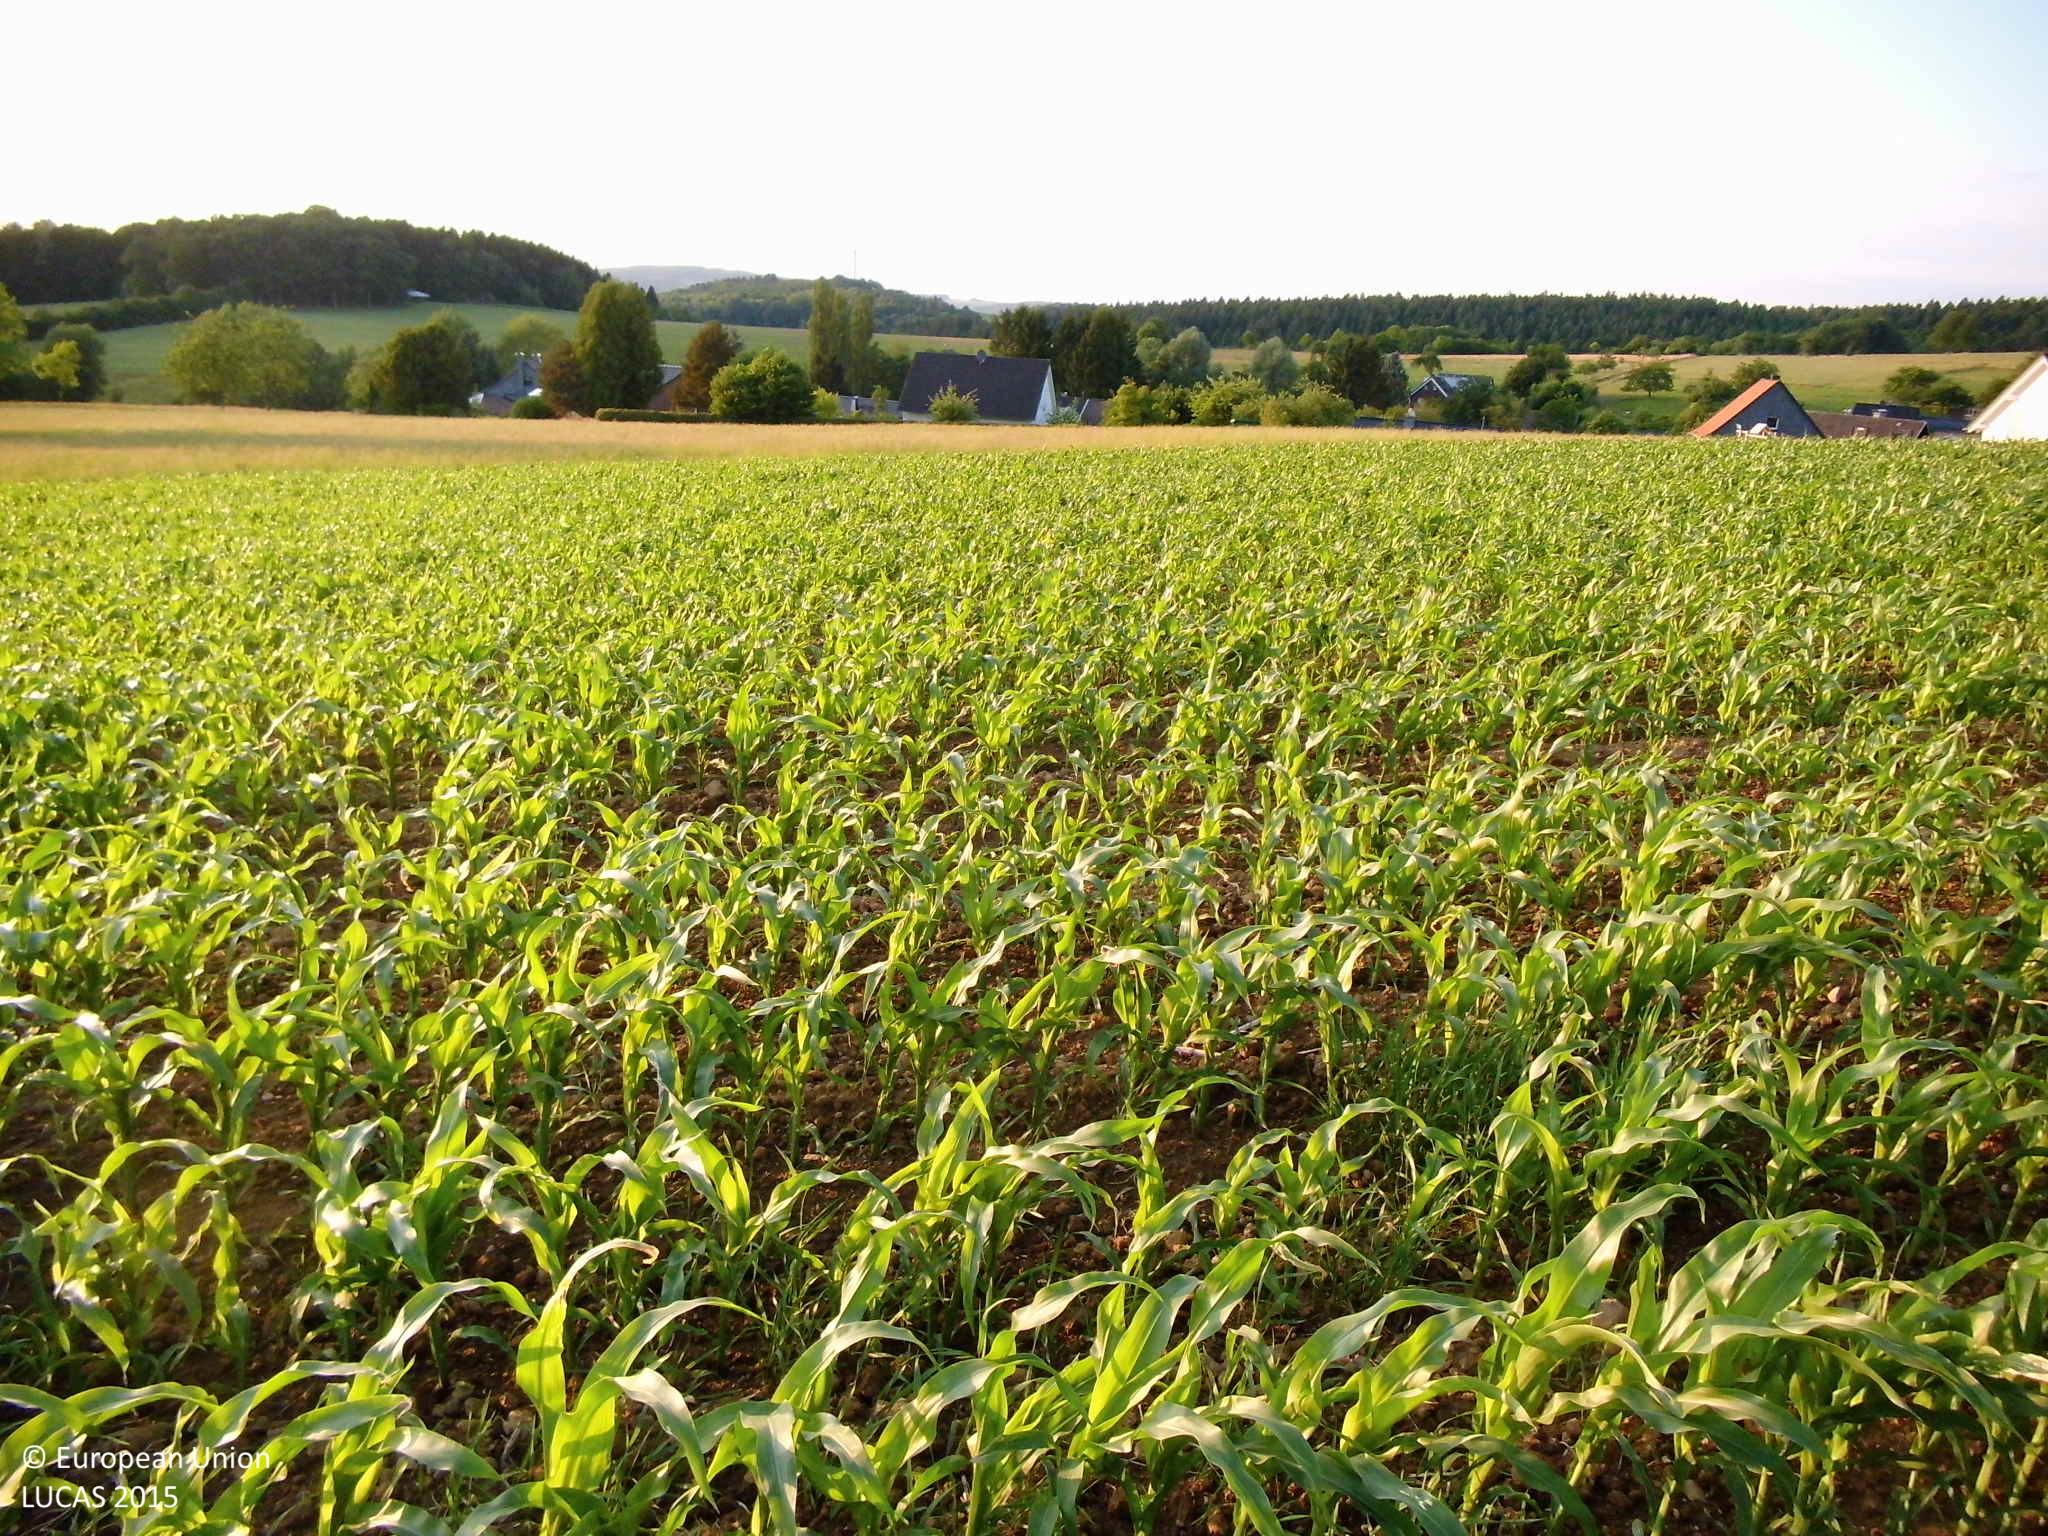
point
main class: Cropland
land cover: Maize
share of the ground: 50 - 75 %
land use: Agriculture (excluding fallow land and kitchen gardens)
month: June
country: DE
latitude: 50.8575
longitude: 7.4573
